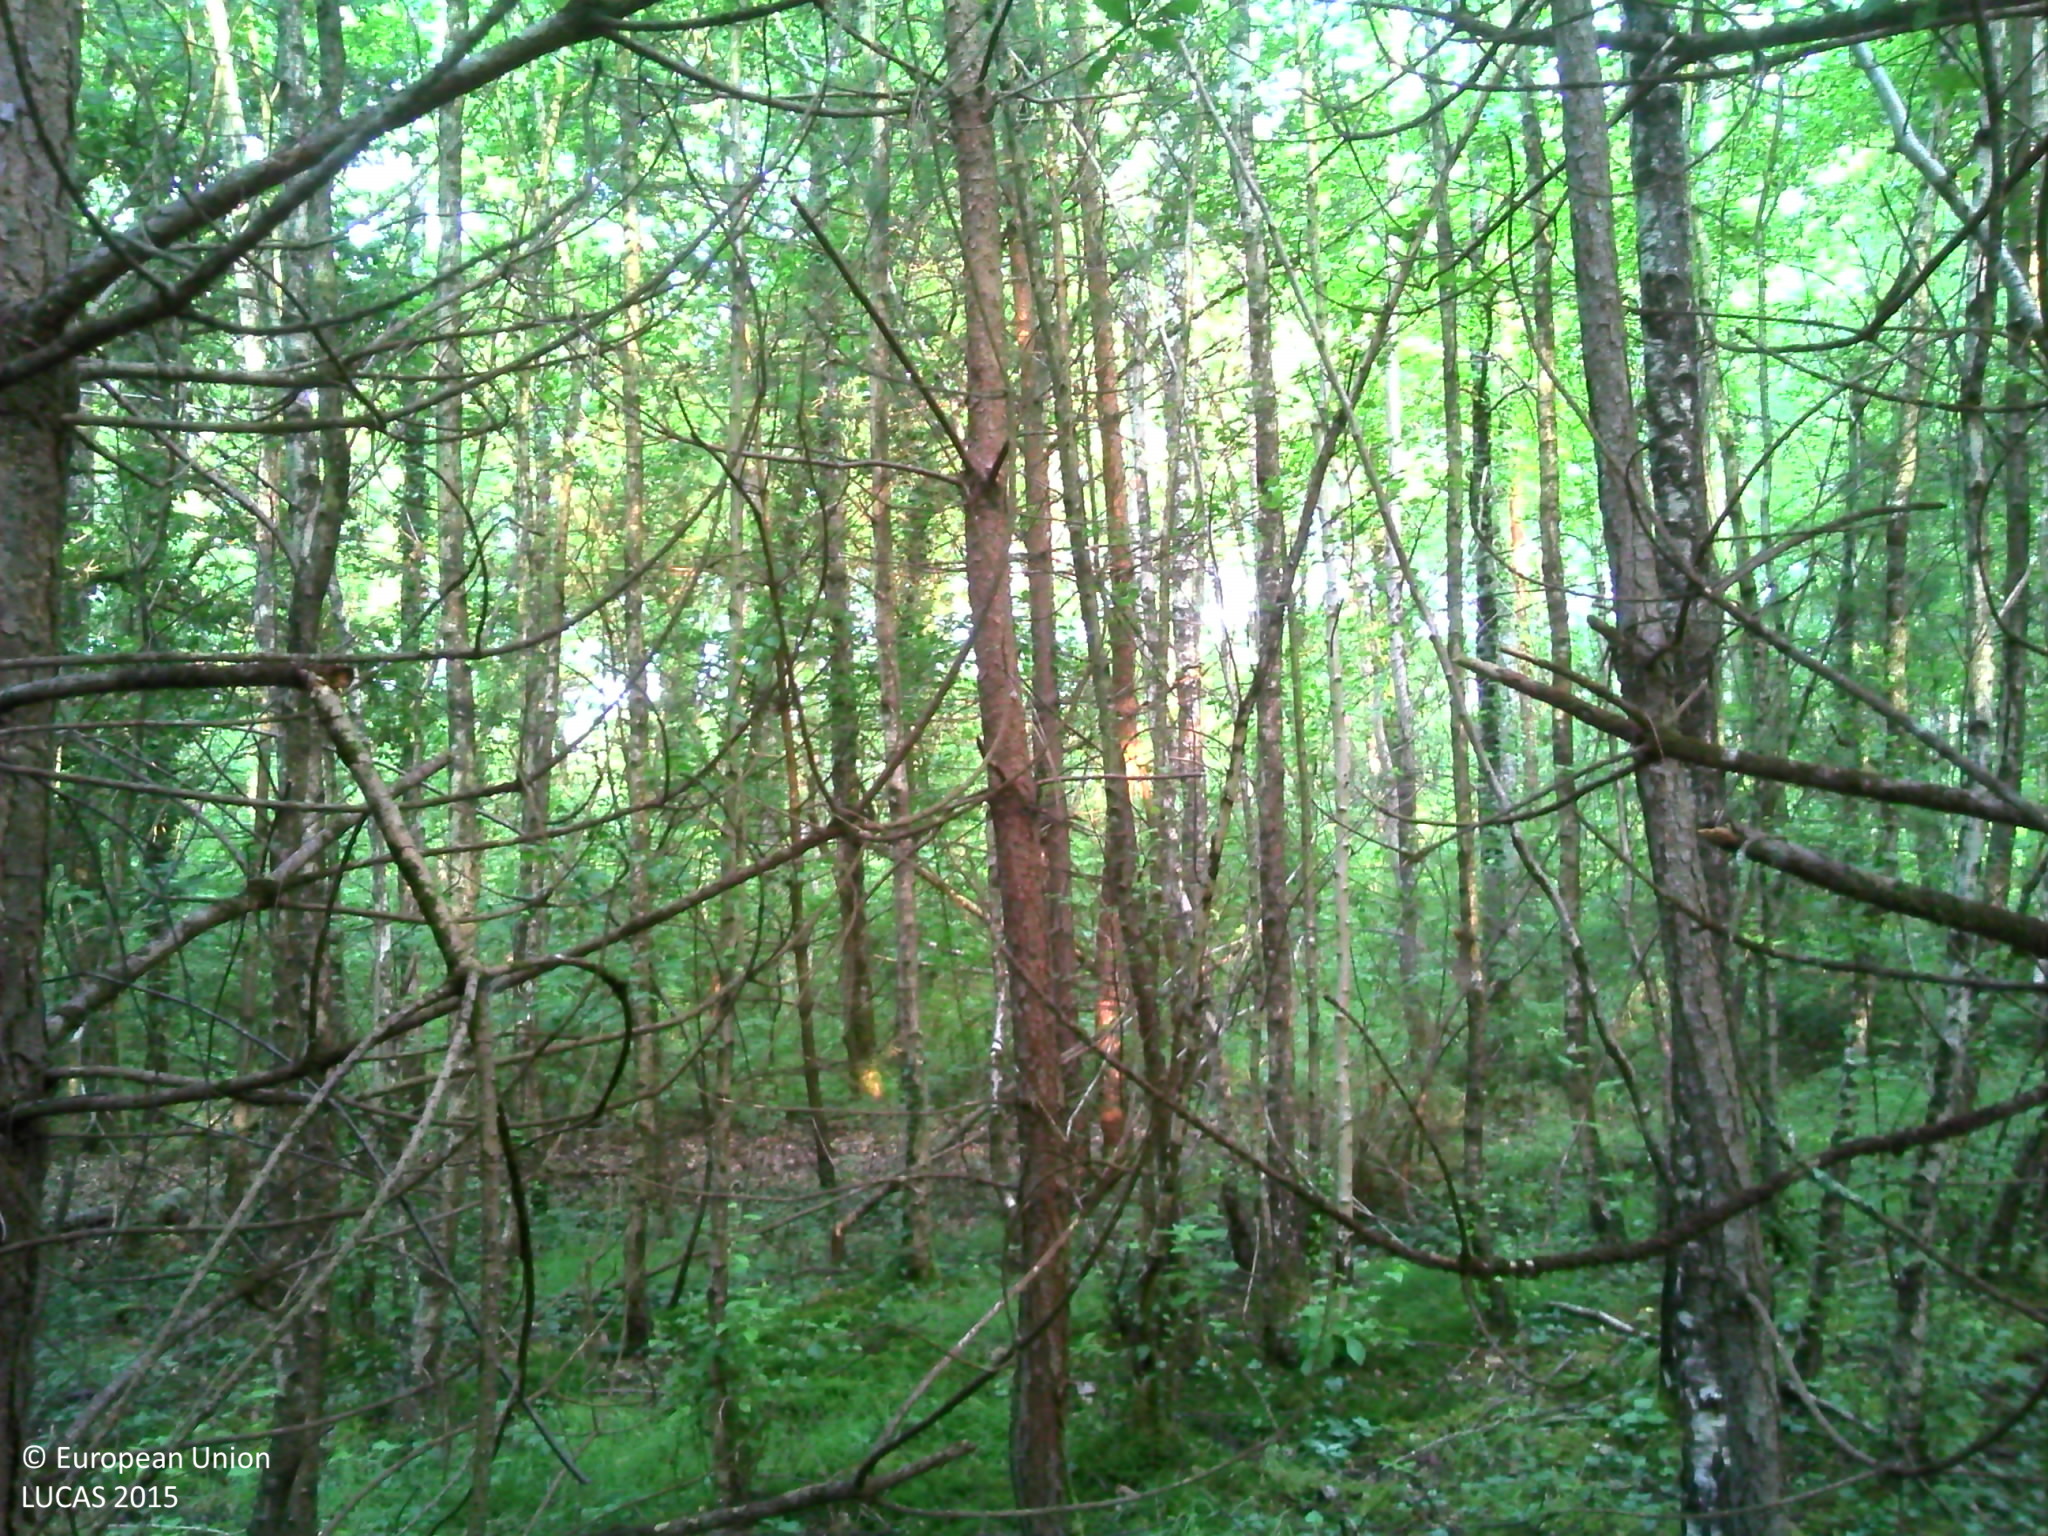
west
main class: Woodland
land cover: Pine dominated mixed woodland
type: hemiboreal forest and nemoral coniferous forest and mixed broadleaved-coniferous forest
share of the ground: > 75 %
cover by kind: coniferous forest trees 45 %, broadleaved forest trees 45 %, herbaceous plants 10 %
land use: Forestry
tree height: > 5 m
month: June
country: FR
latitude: 47.7178
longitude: 2.0306
